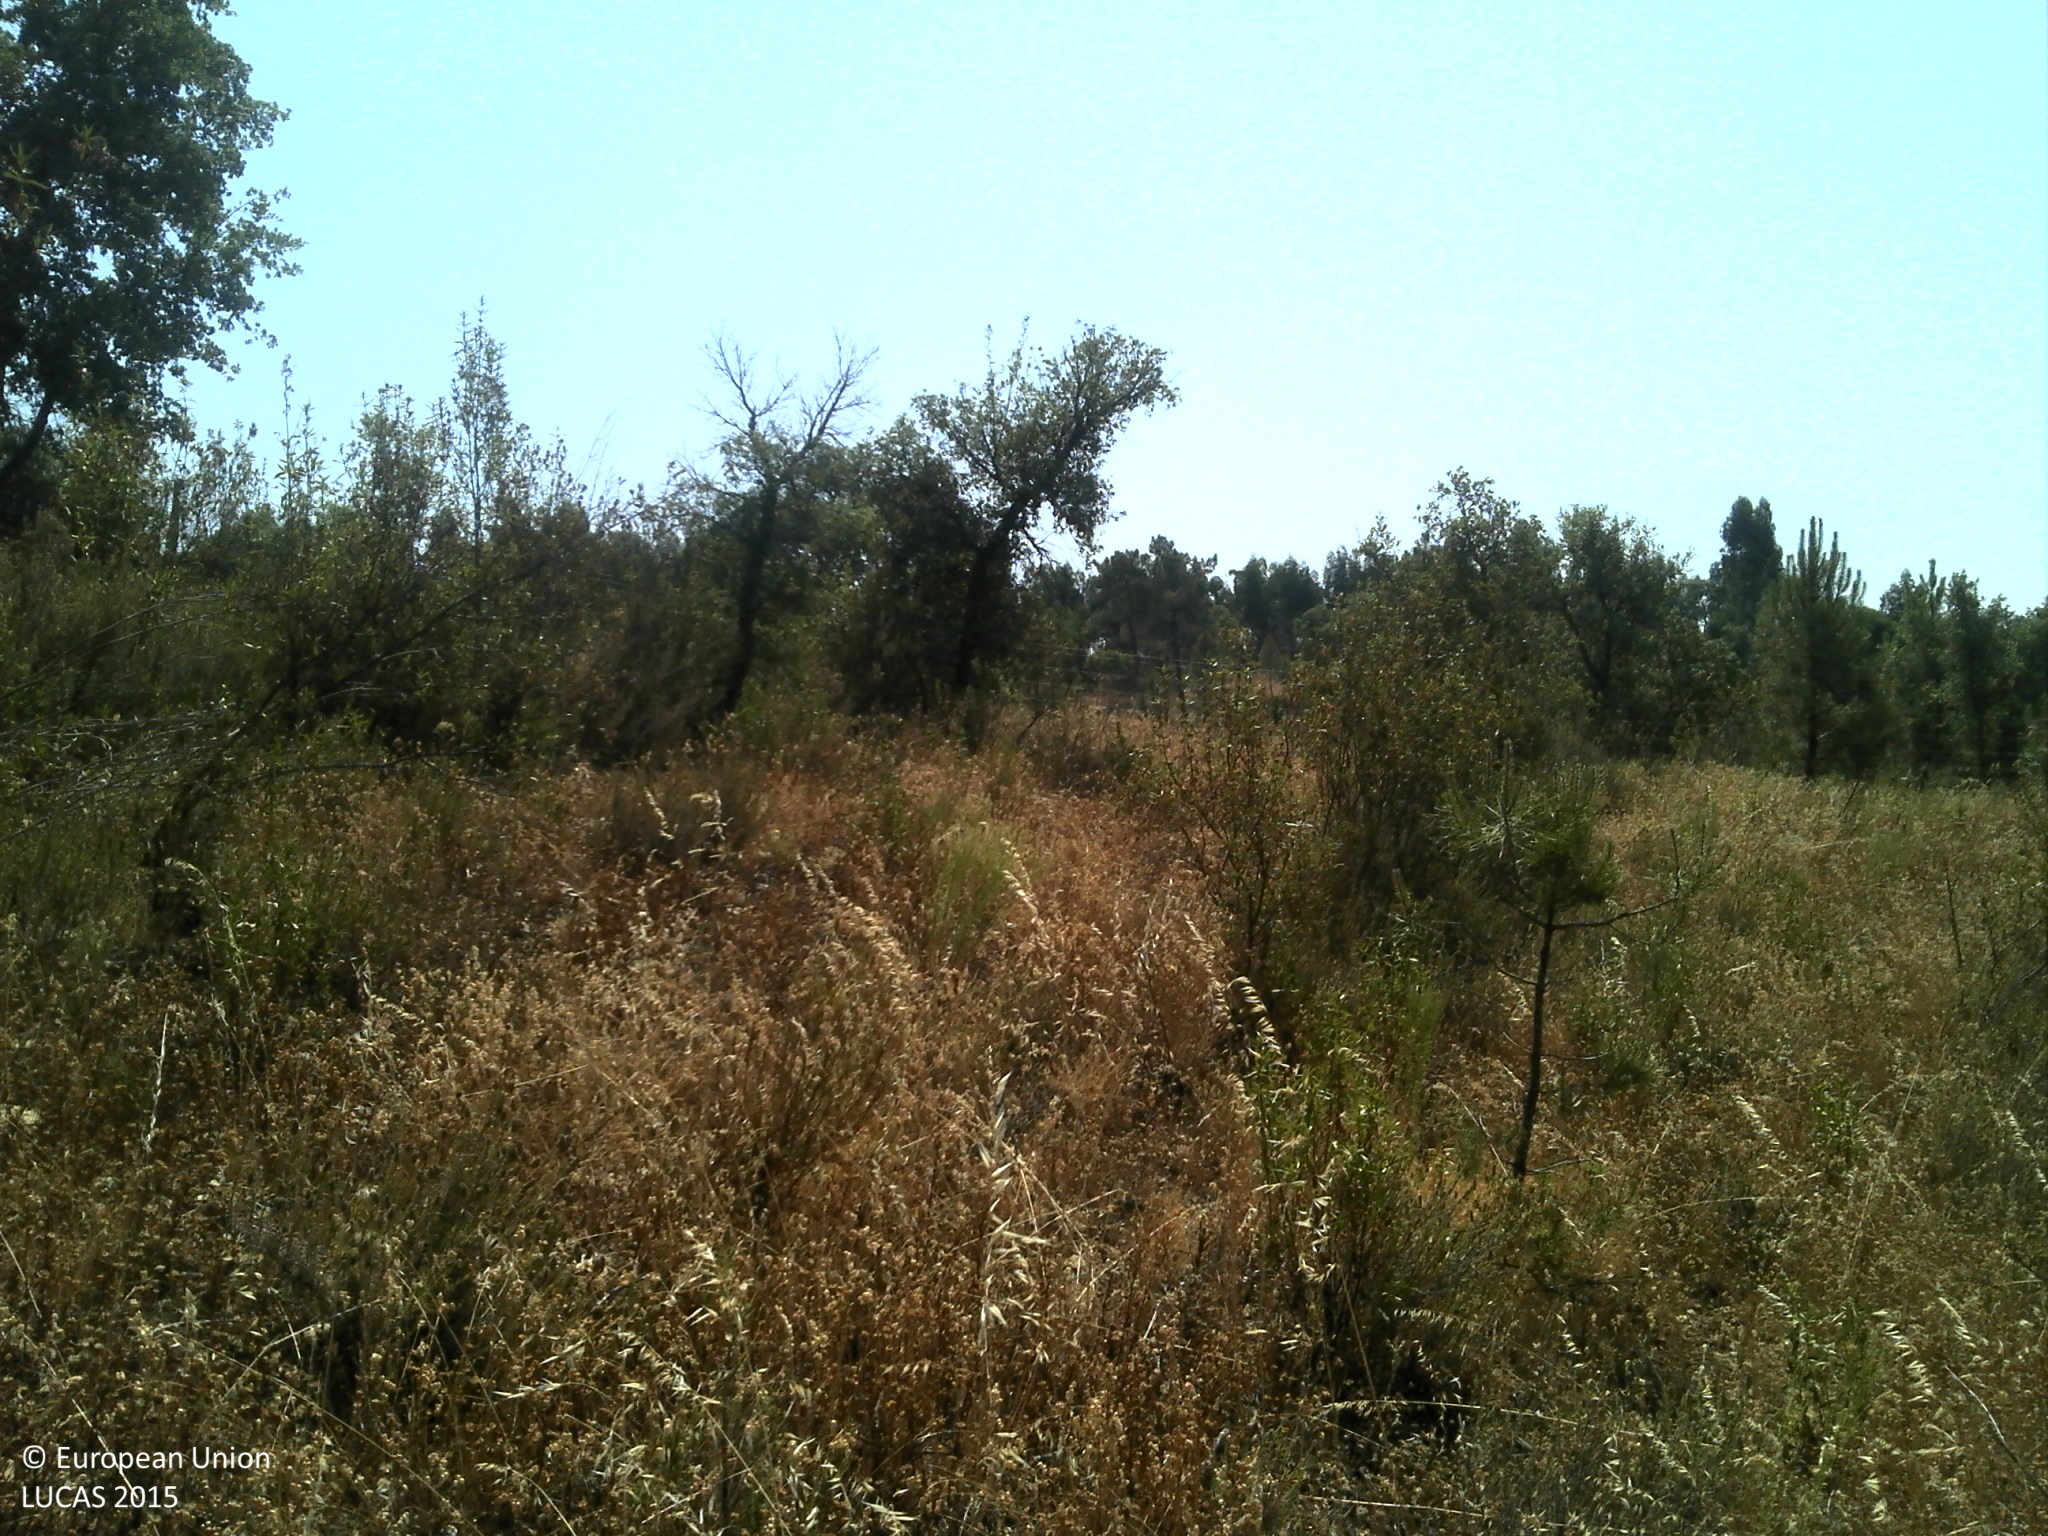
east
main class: Shrubland
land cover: Shrubland with sparse tree cover
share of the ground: > 75 %
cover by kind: shrubs 80 %, lichens and mosses 10 %, broadleaved forest trees 5 %, unconsolidated bare surface 5 %
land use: Semi-natural and natural areas not in use
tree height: < 5 m
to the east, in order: Shrubland with sparse tree cover; Other bare soil; Fences; Broadleaved woodland; Shrubland with sparse tree cover; Broadleaved woodland
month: June
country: PT
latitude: 39.4526
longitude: -7.9178
